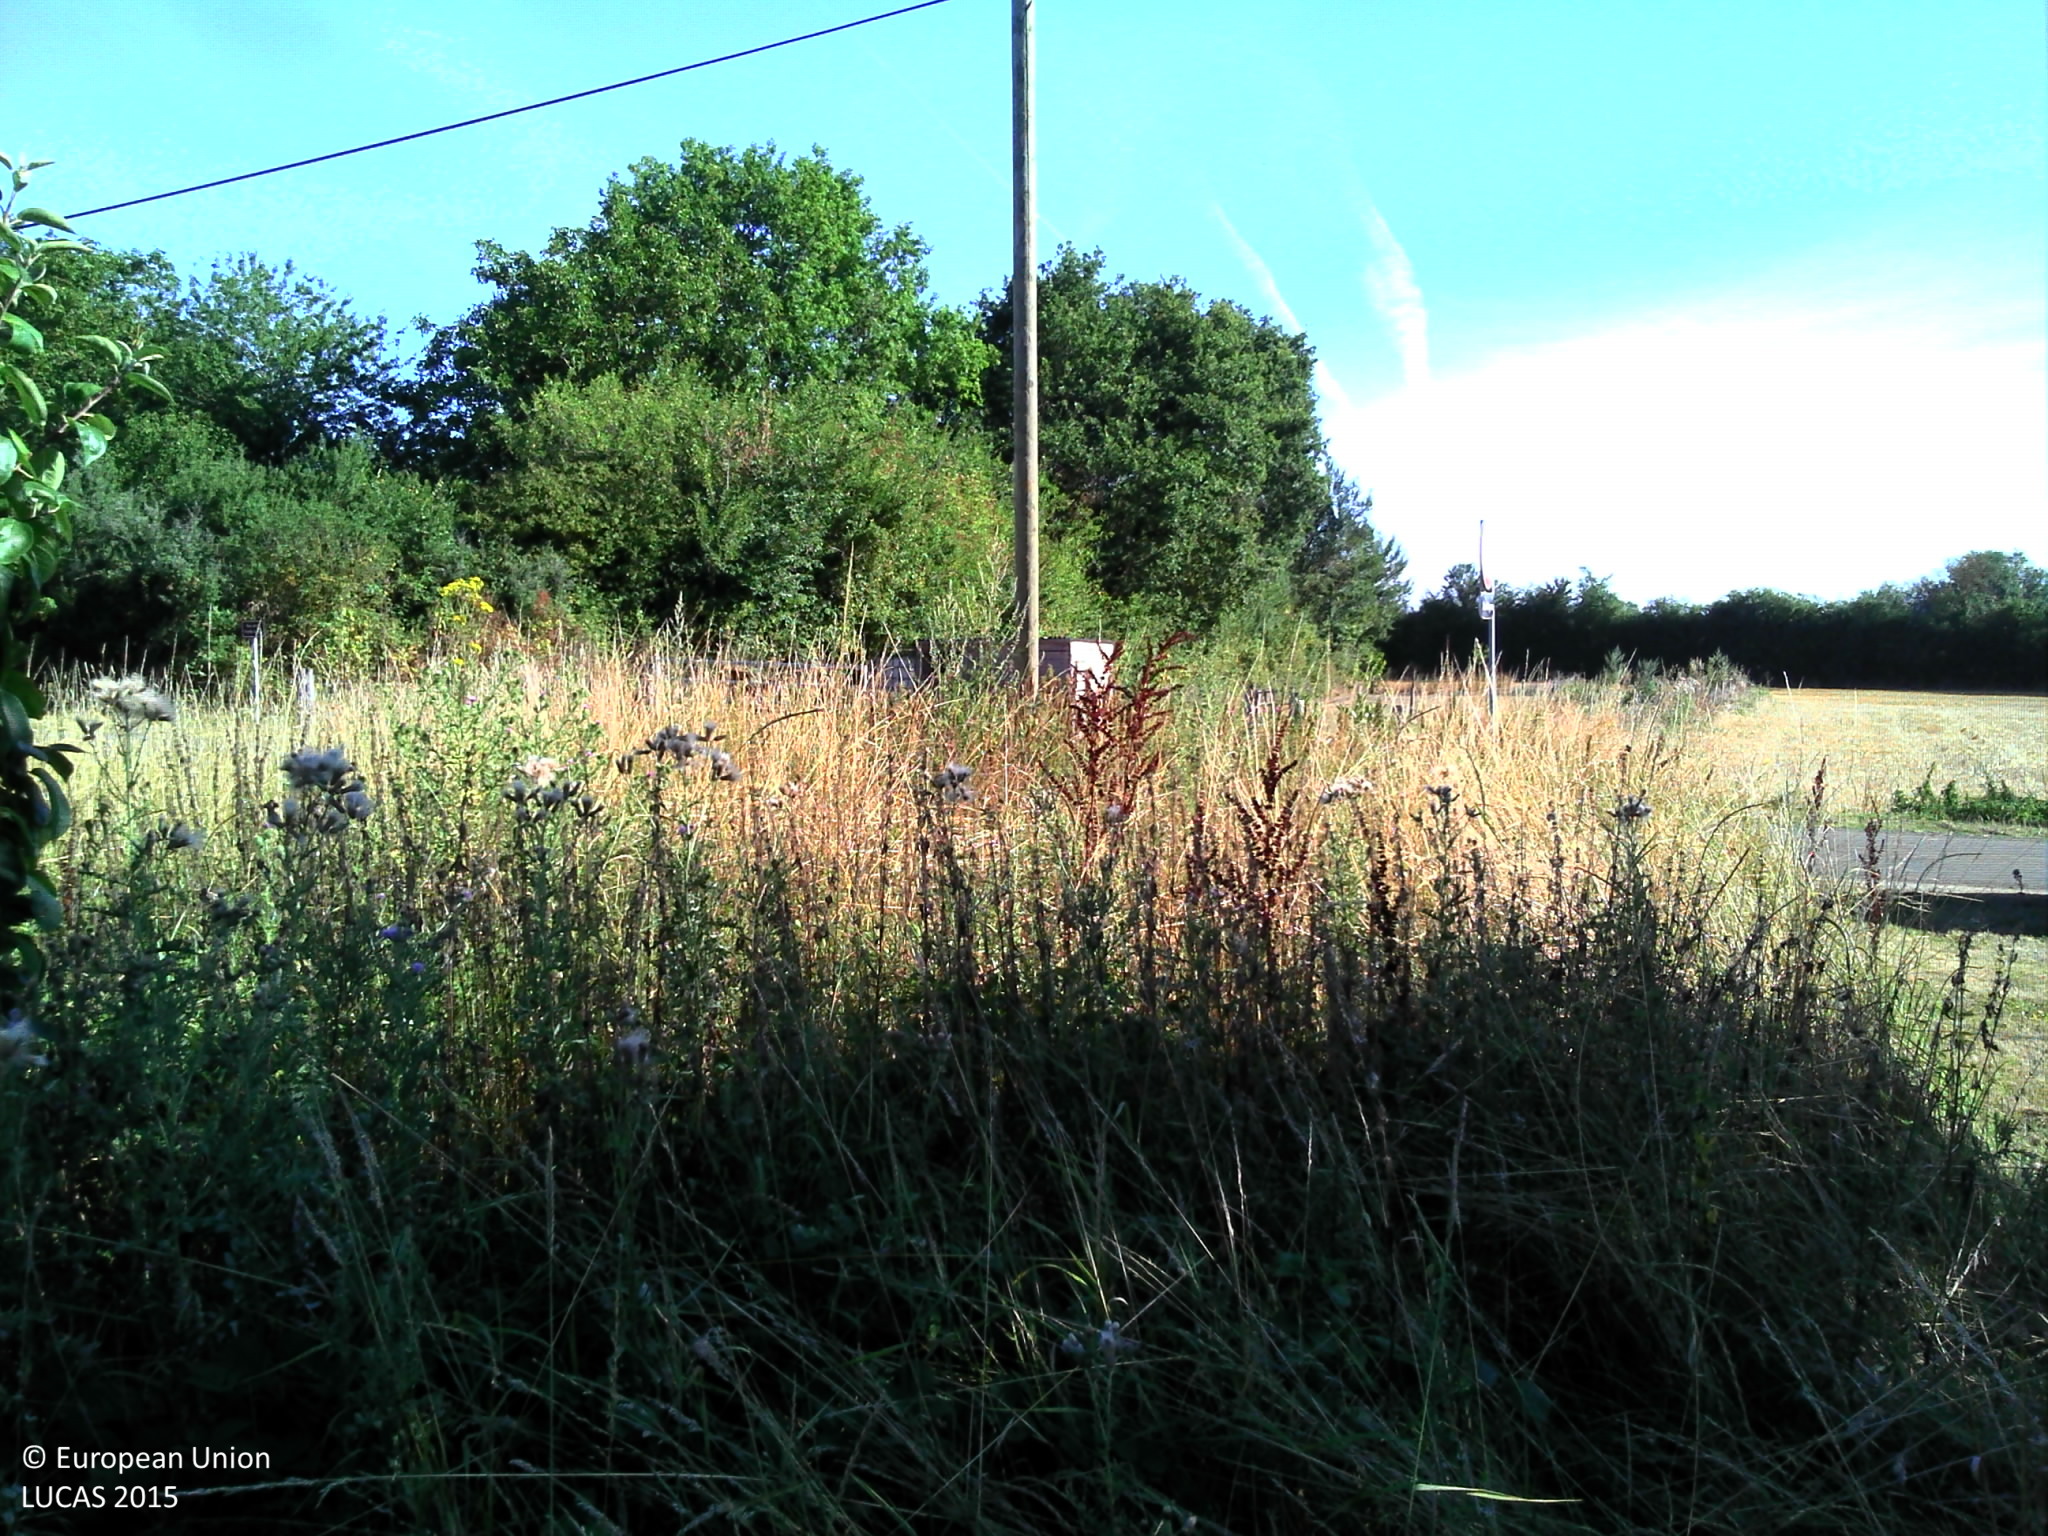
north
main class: Grassland
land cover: Grassland with sparse tree/shrub cover
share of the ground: > 75 %
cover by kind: herbaceous plants 95 %, broadleaved forest trees 5 %
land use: Residential
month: July
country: FR
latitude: 46.3789
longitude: 0.4789
